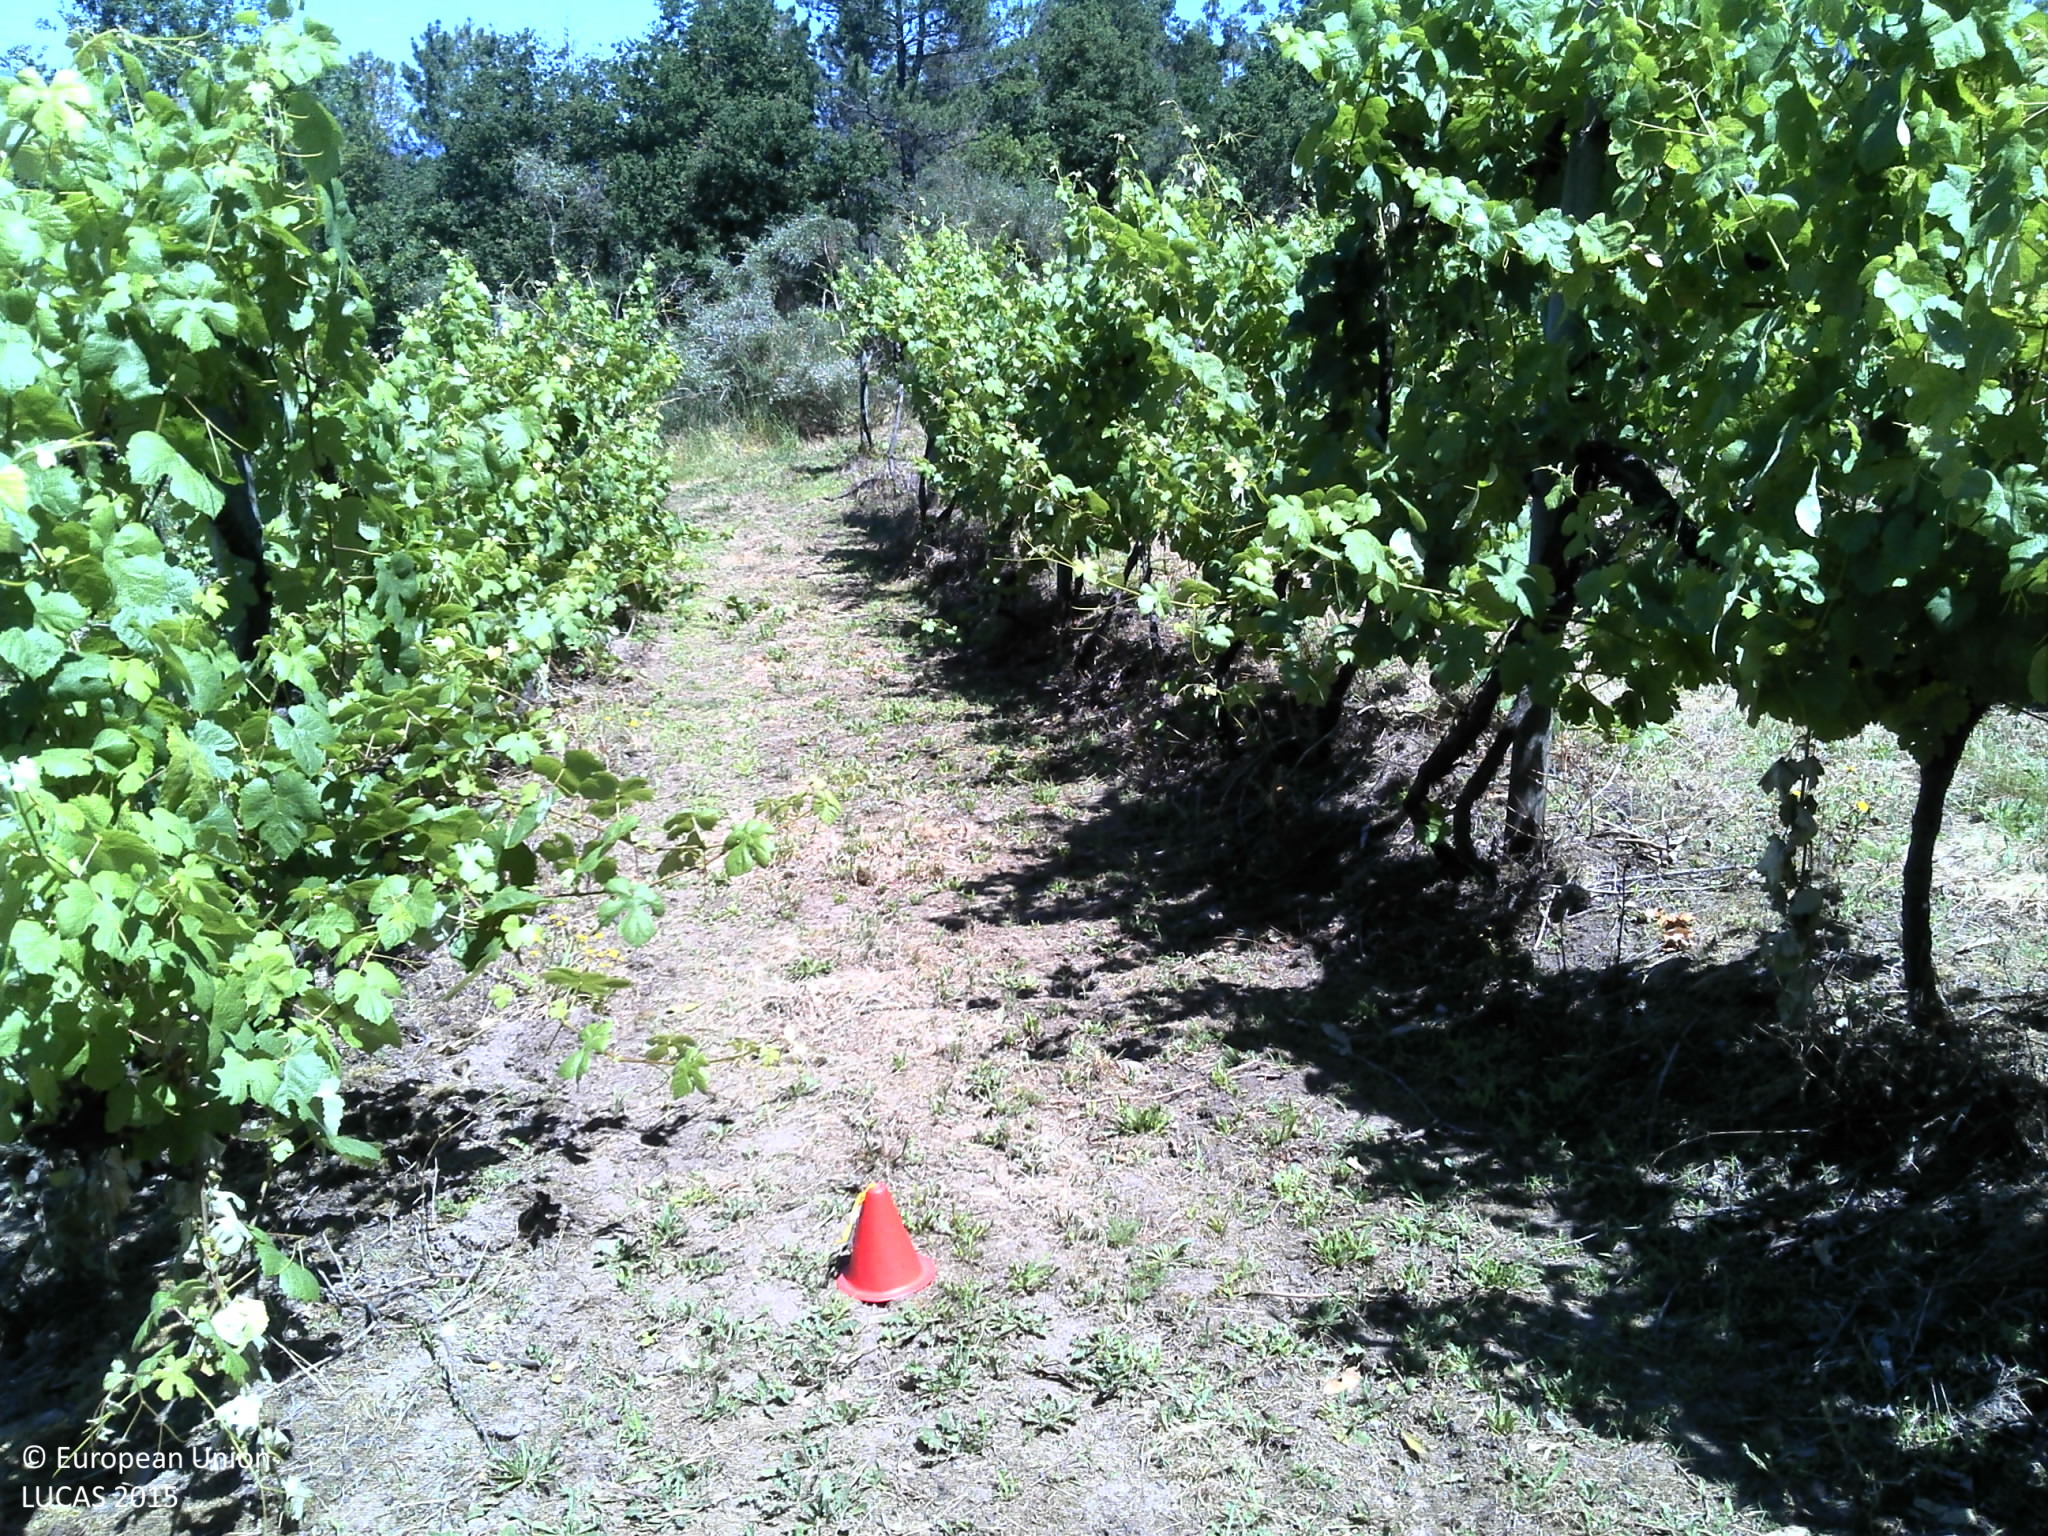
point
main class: Cropland
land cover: Vineyards
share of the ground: 10 - 25 %
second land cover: Spontaneously vegetated surfaces
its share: 10 - 25 %
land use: Agriculture (excluding fallow land and kitchen gardens)
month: May
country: PT
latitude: 41.7237
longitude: -8.6145
